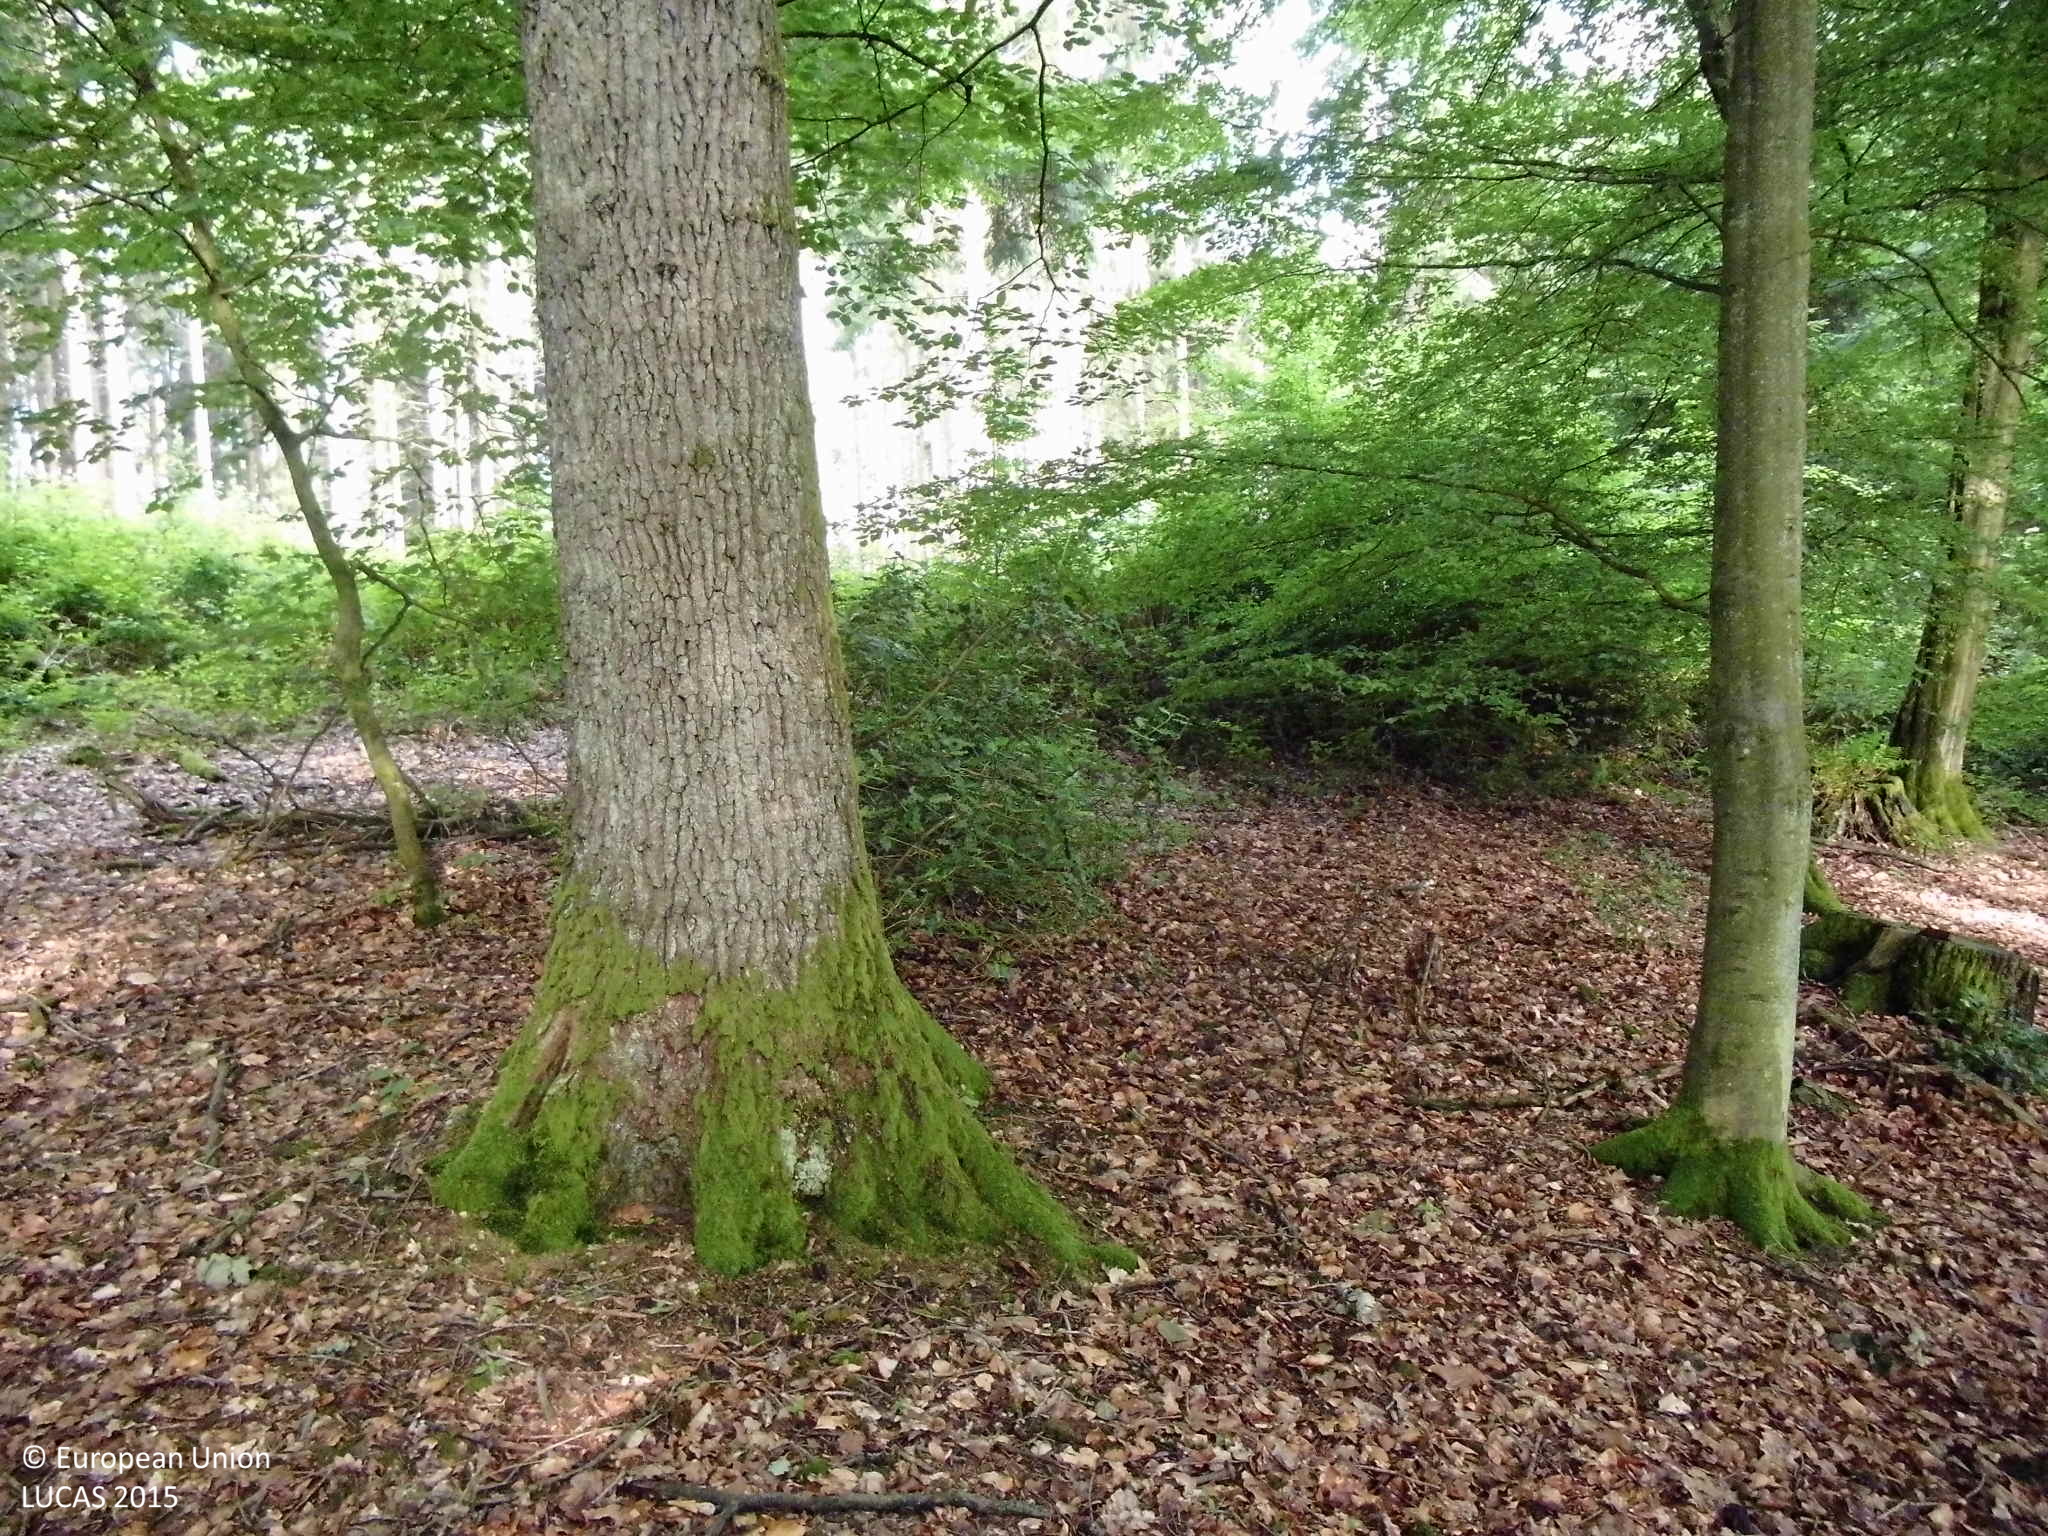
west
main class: Woodland
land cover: Broadleaved woodland
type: mesophytic deciduous forest
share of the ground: > 75 %
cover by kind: broadleaved forest trees 95 %, unconsolidated bare surface 5 %
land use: Forestry
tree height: > 5 m
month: June
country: DE
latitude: 50.8209
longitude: 7.4309
